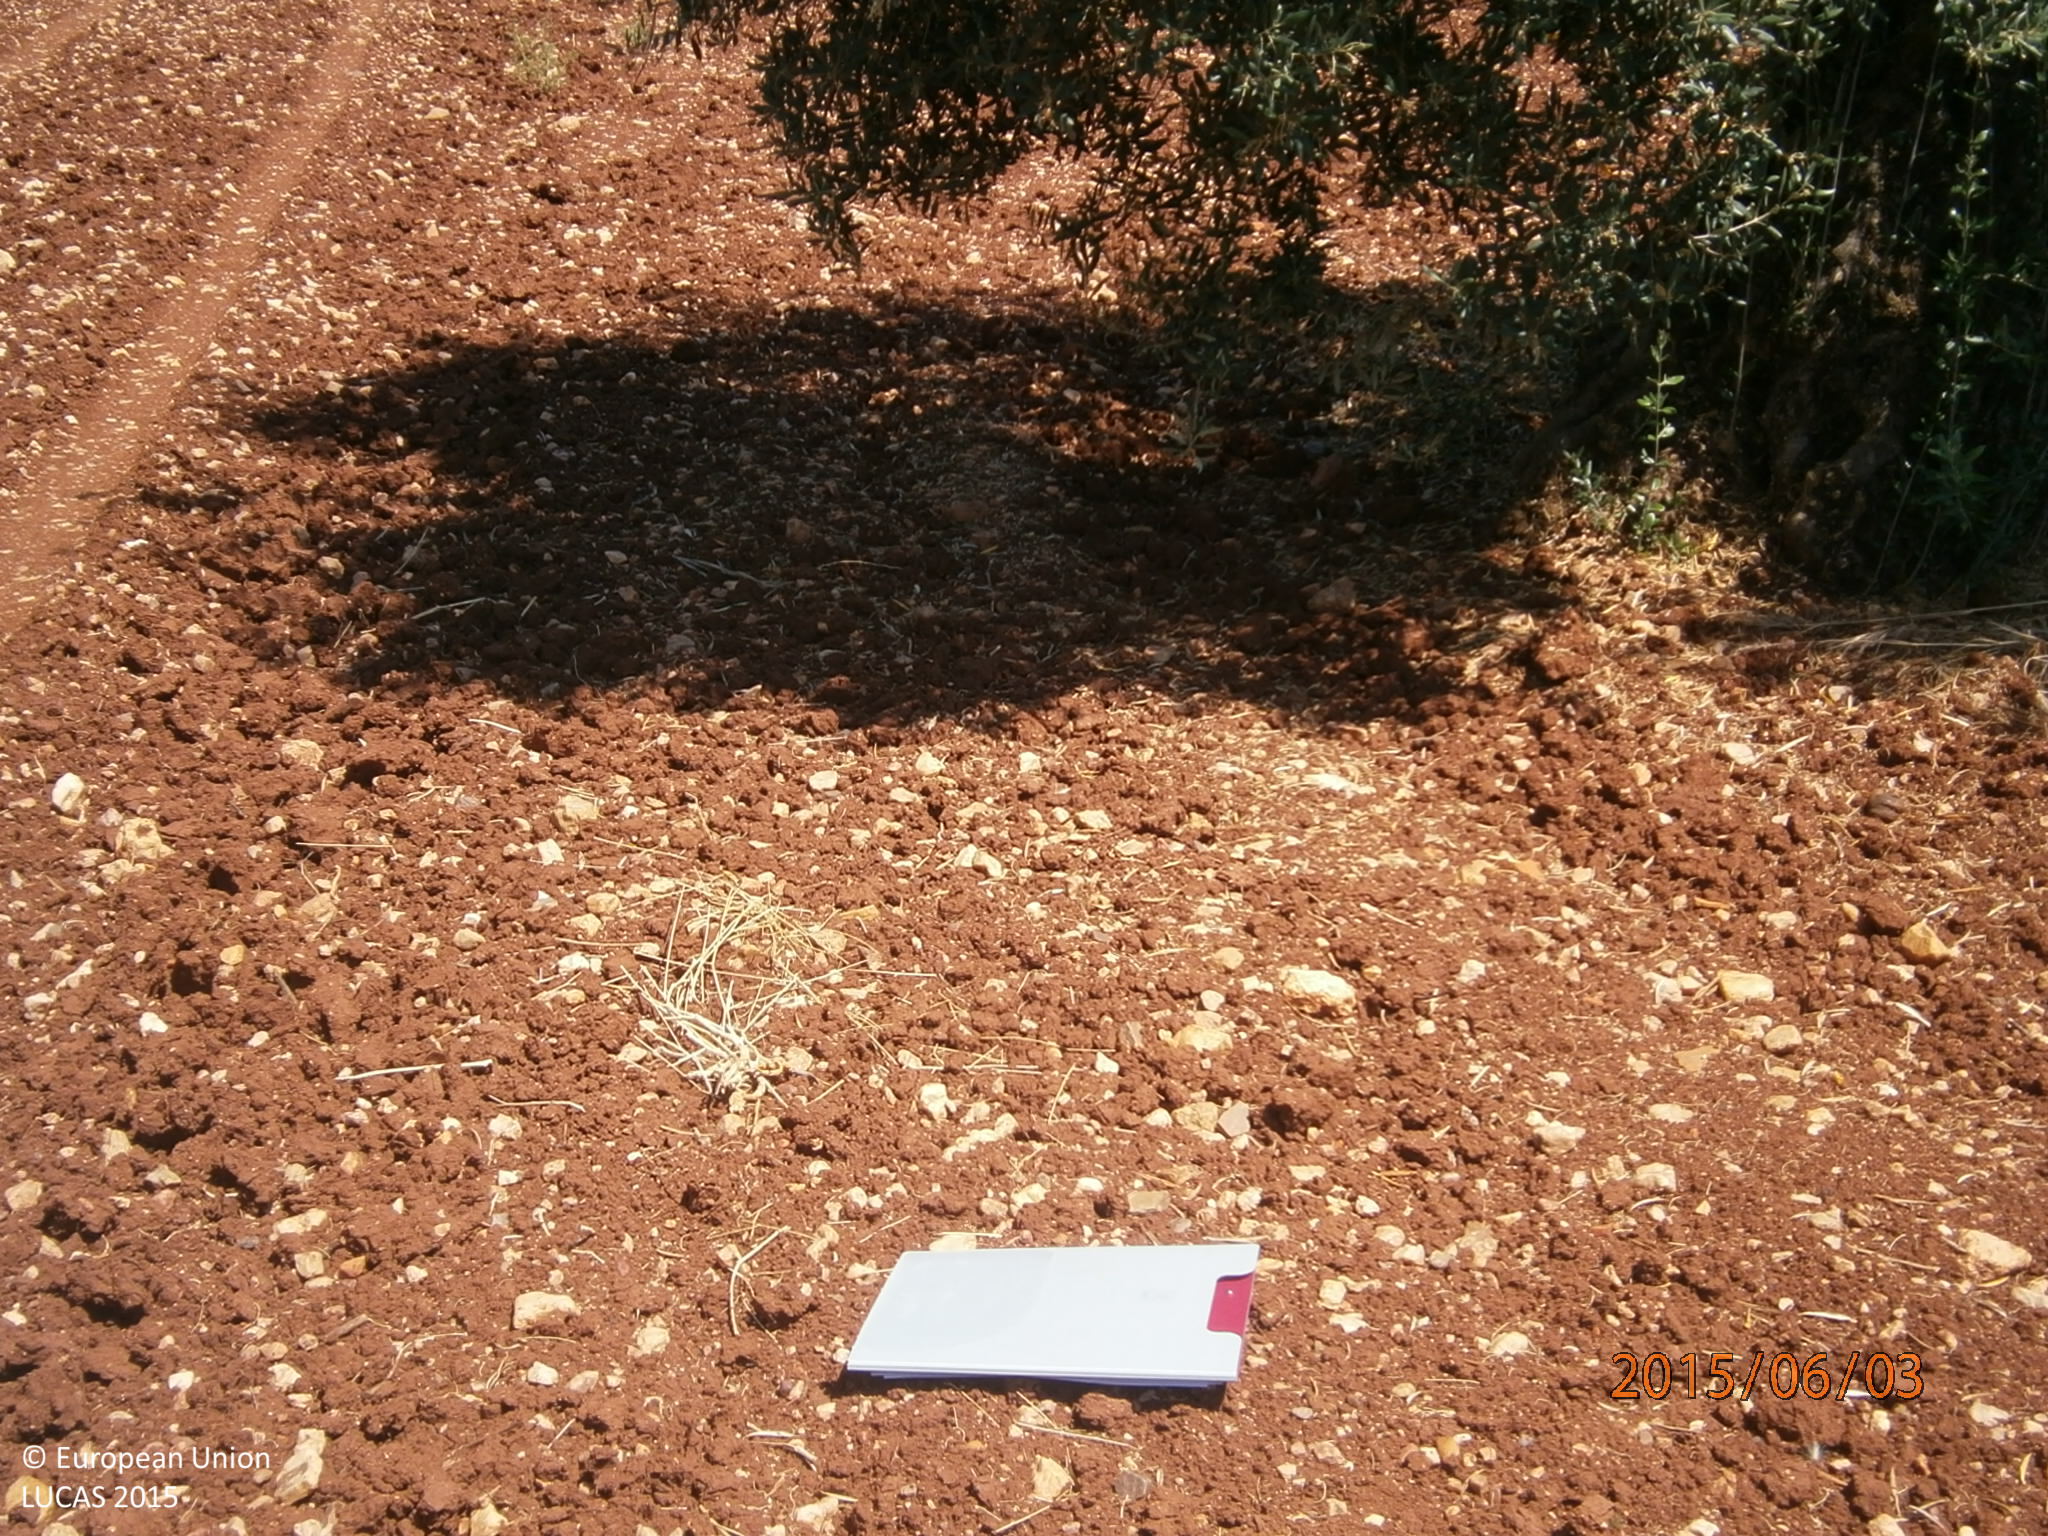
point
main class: Cropland
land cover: Olive groves
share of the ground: 10 - 25 %
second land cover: Other bare soil
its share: > 75 %
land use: Agriculture (excluding fallow land and kitchen gardens)
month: June
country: ES
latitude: 38.6192
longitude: -6.3971
